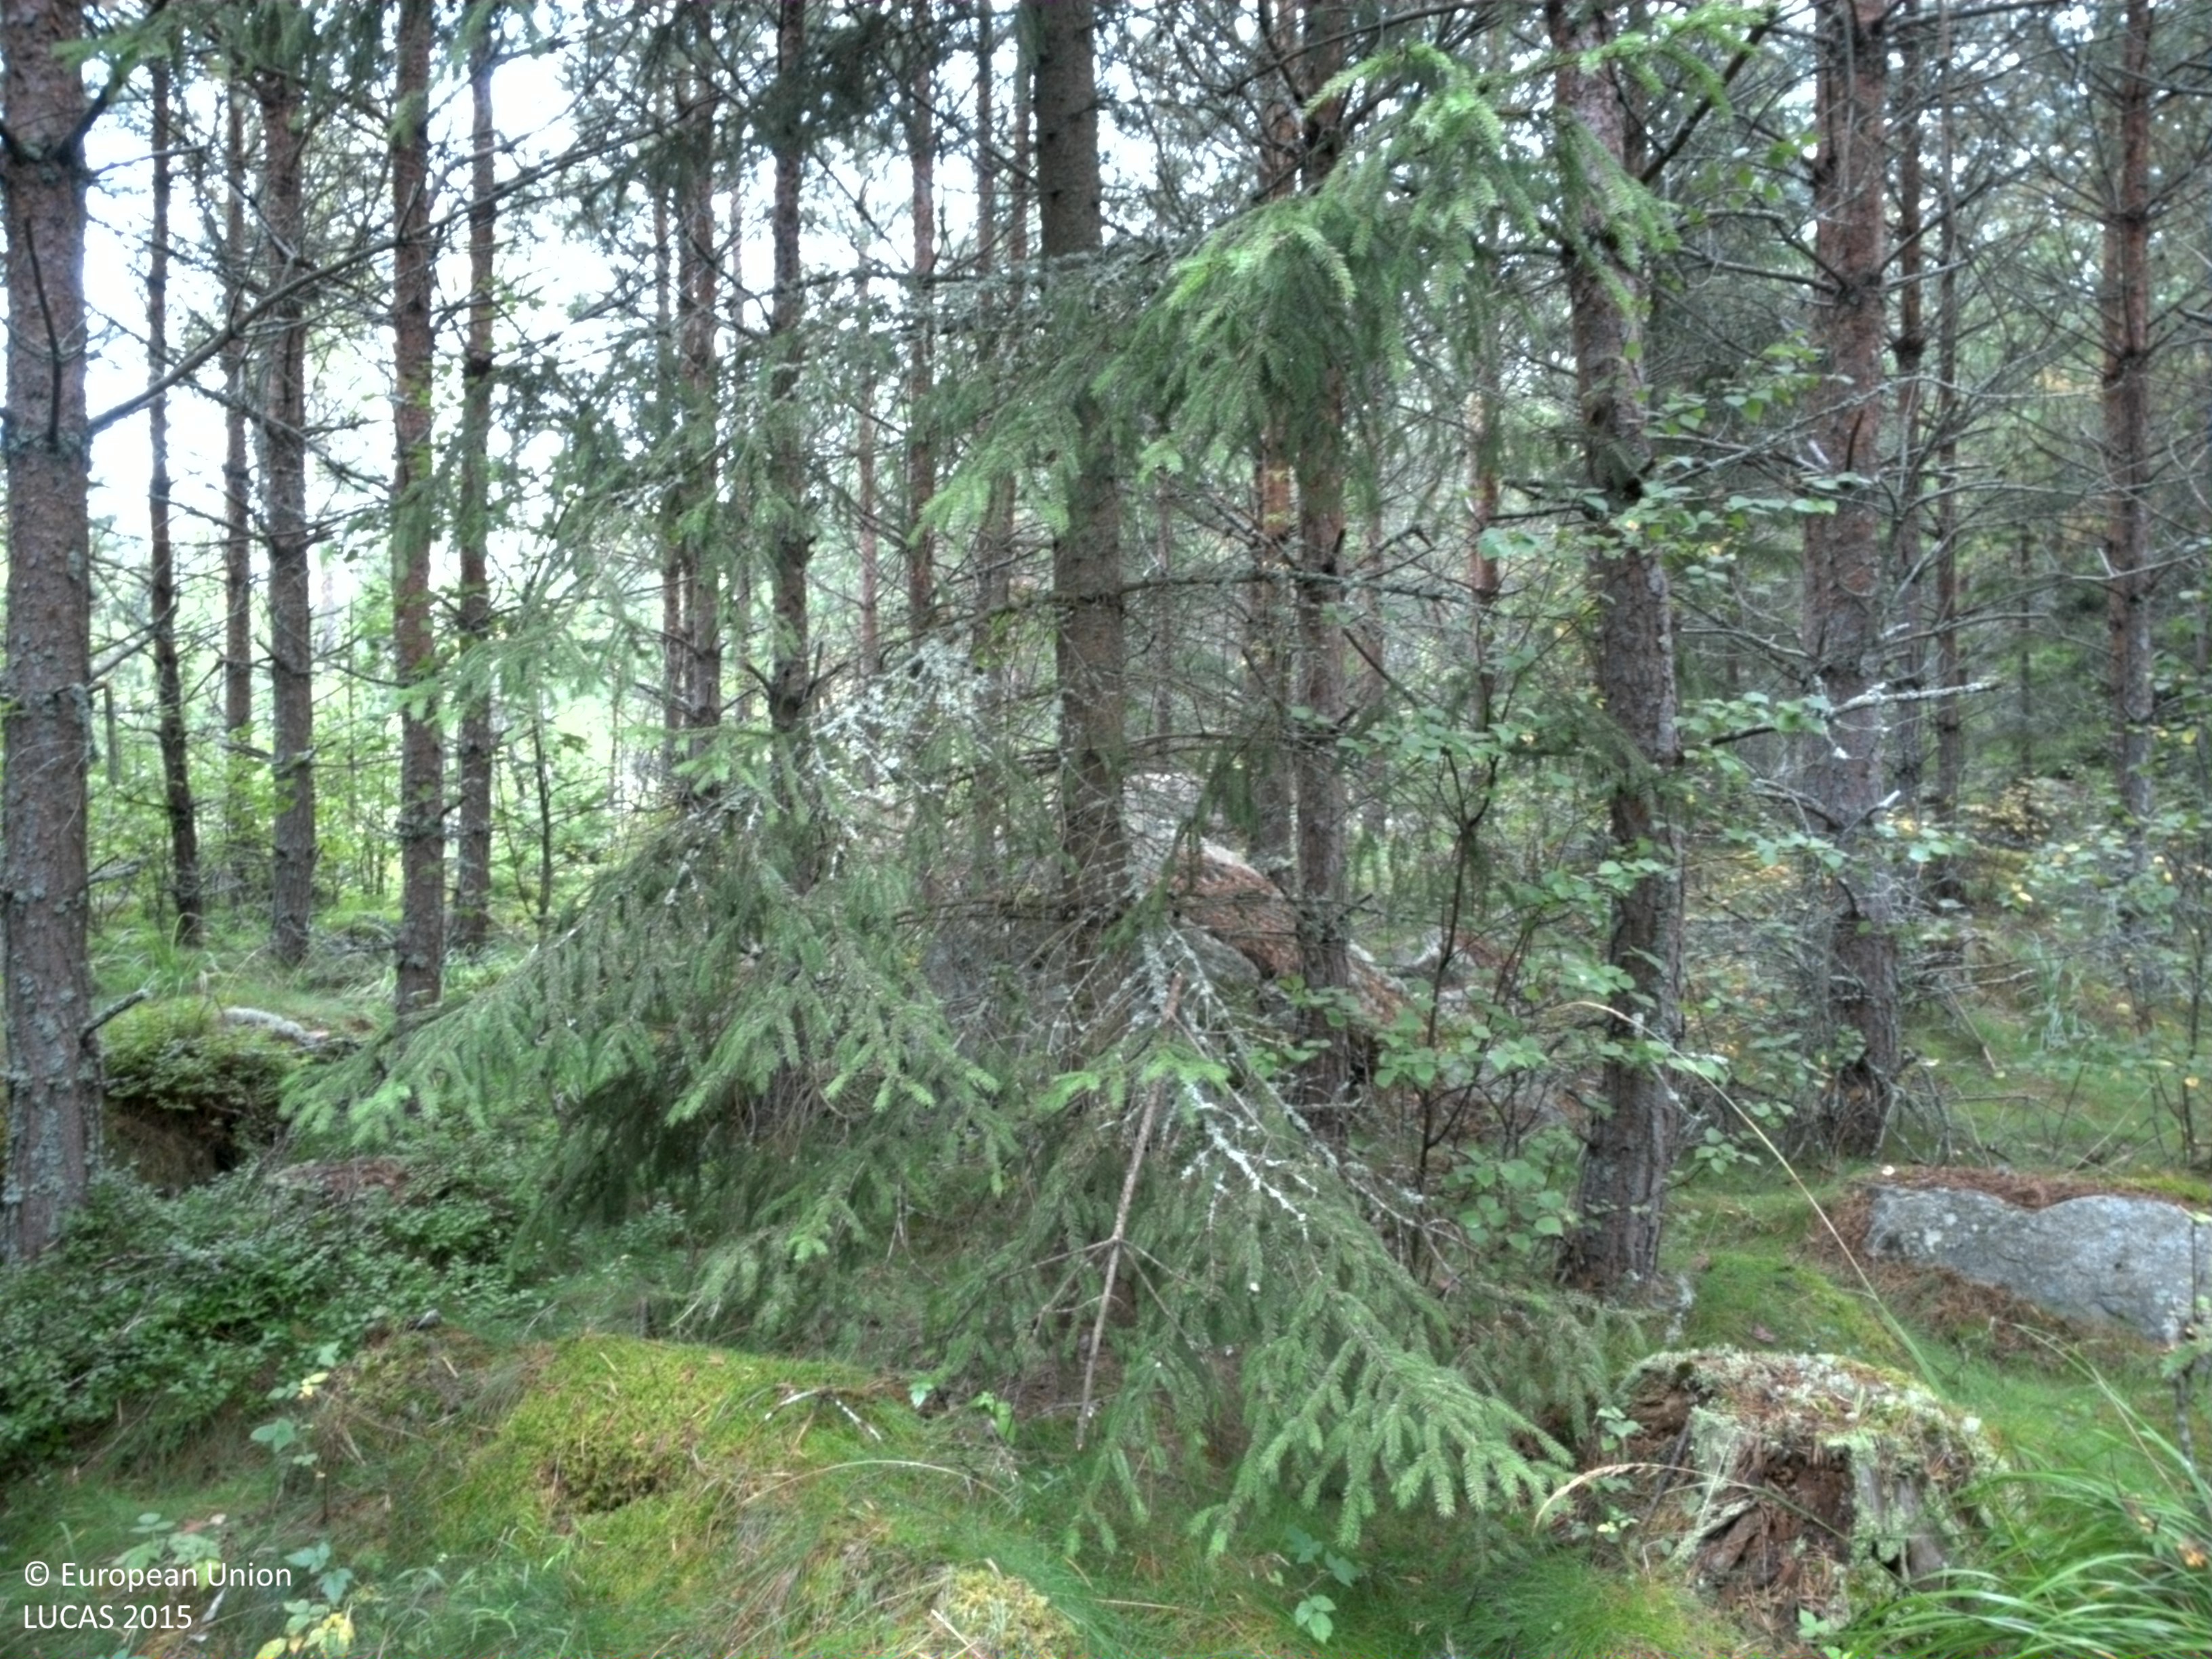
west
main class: Woodland
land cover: Pine dominated coniferous woodland
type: boreal forest
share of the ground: 50 - 75 %
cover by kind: coniferous forest trees 65 %, herbaceous plants 25 %, broadleaved forest trees 10 %
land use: Forestry
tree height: > 5 m
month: August
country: SE
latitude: 59.9355
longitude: 17.6713
